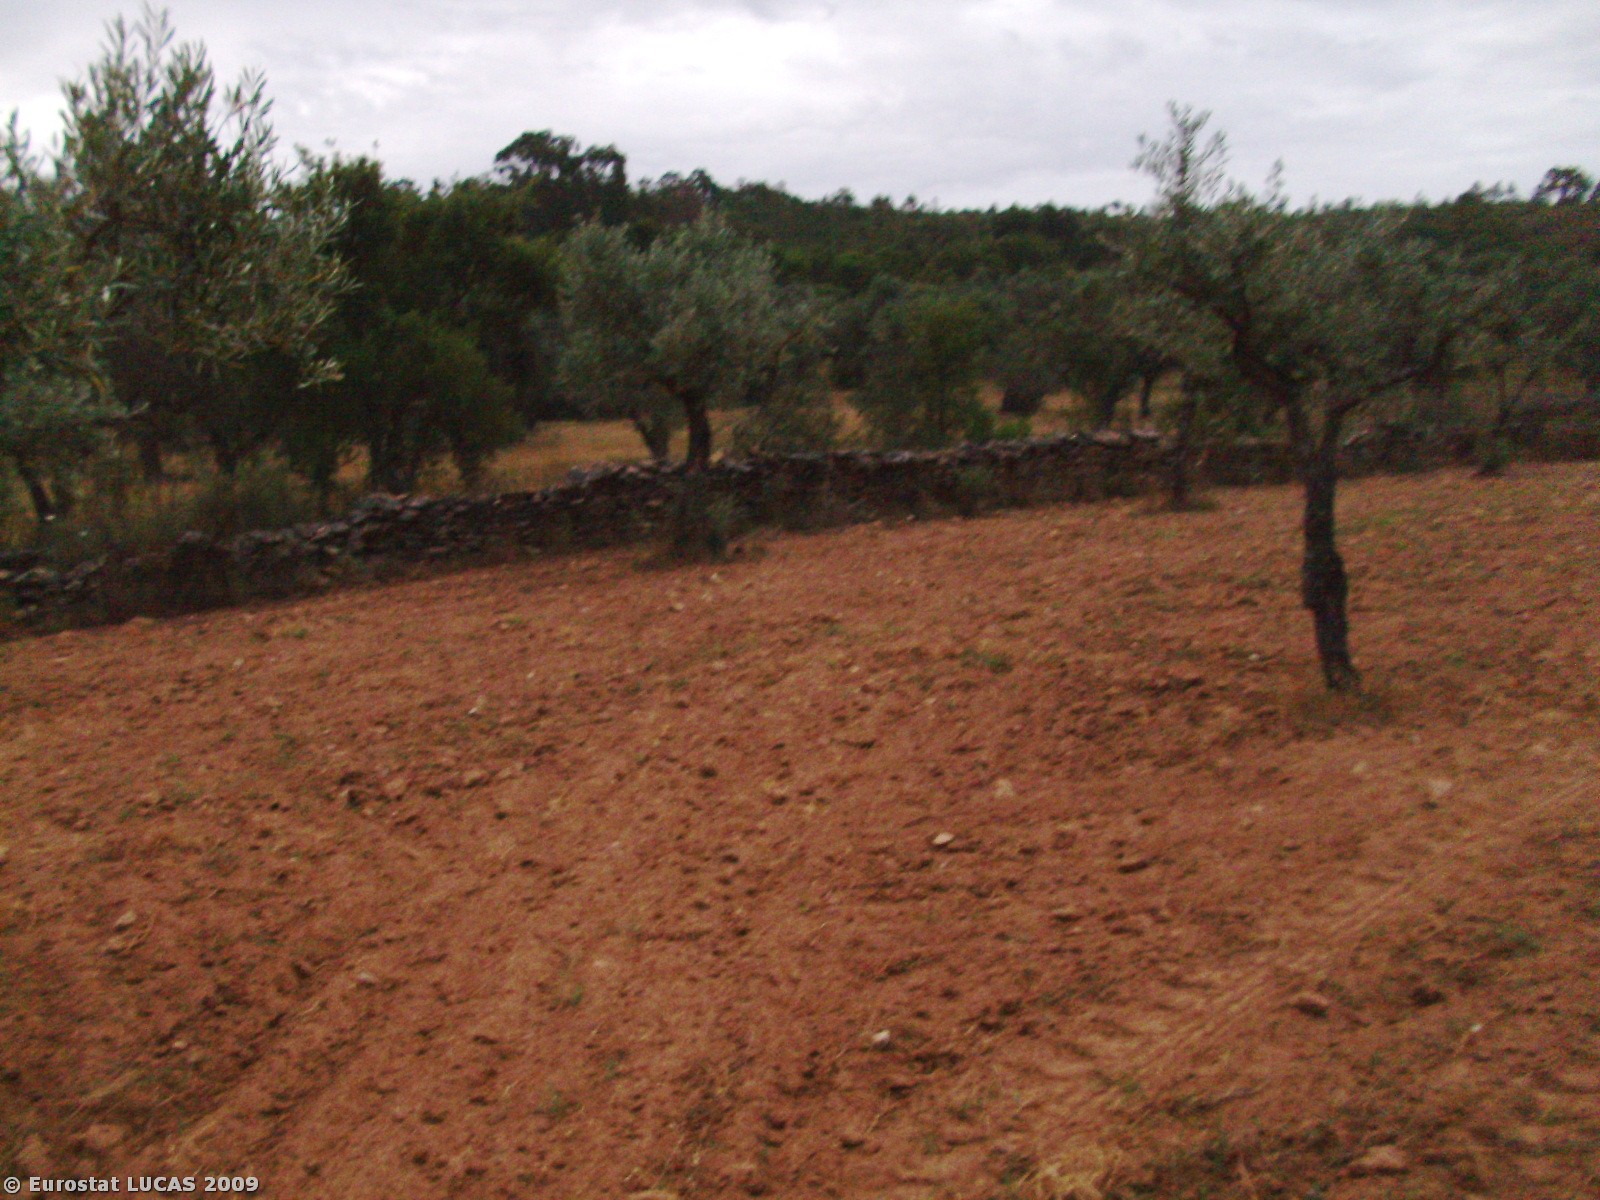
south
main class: Cropland
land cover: Olive groves
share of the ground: 50 - 75 %
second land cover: Bare land
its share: 25 - 50 %
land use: Agriculture (excluding fallow land and kitchen gardens)
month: June
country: PT
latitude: 39.9229
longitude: -7.5710
